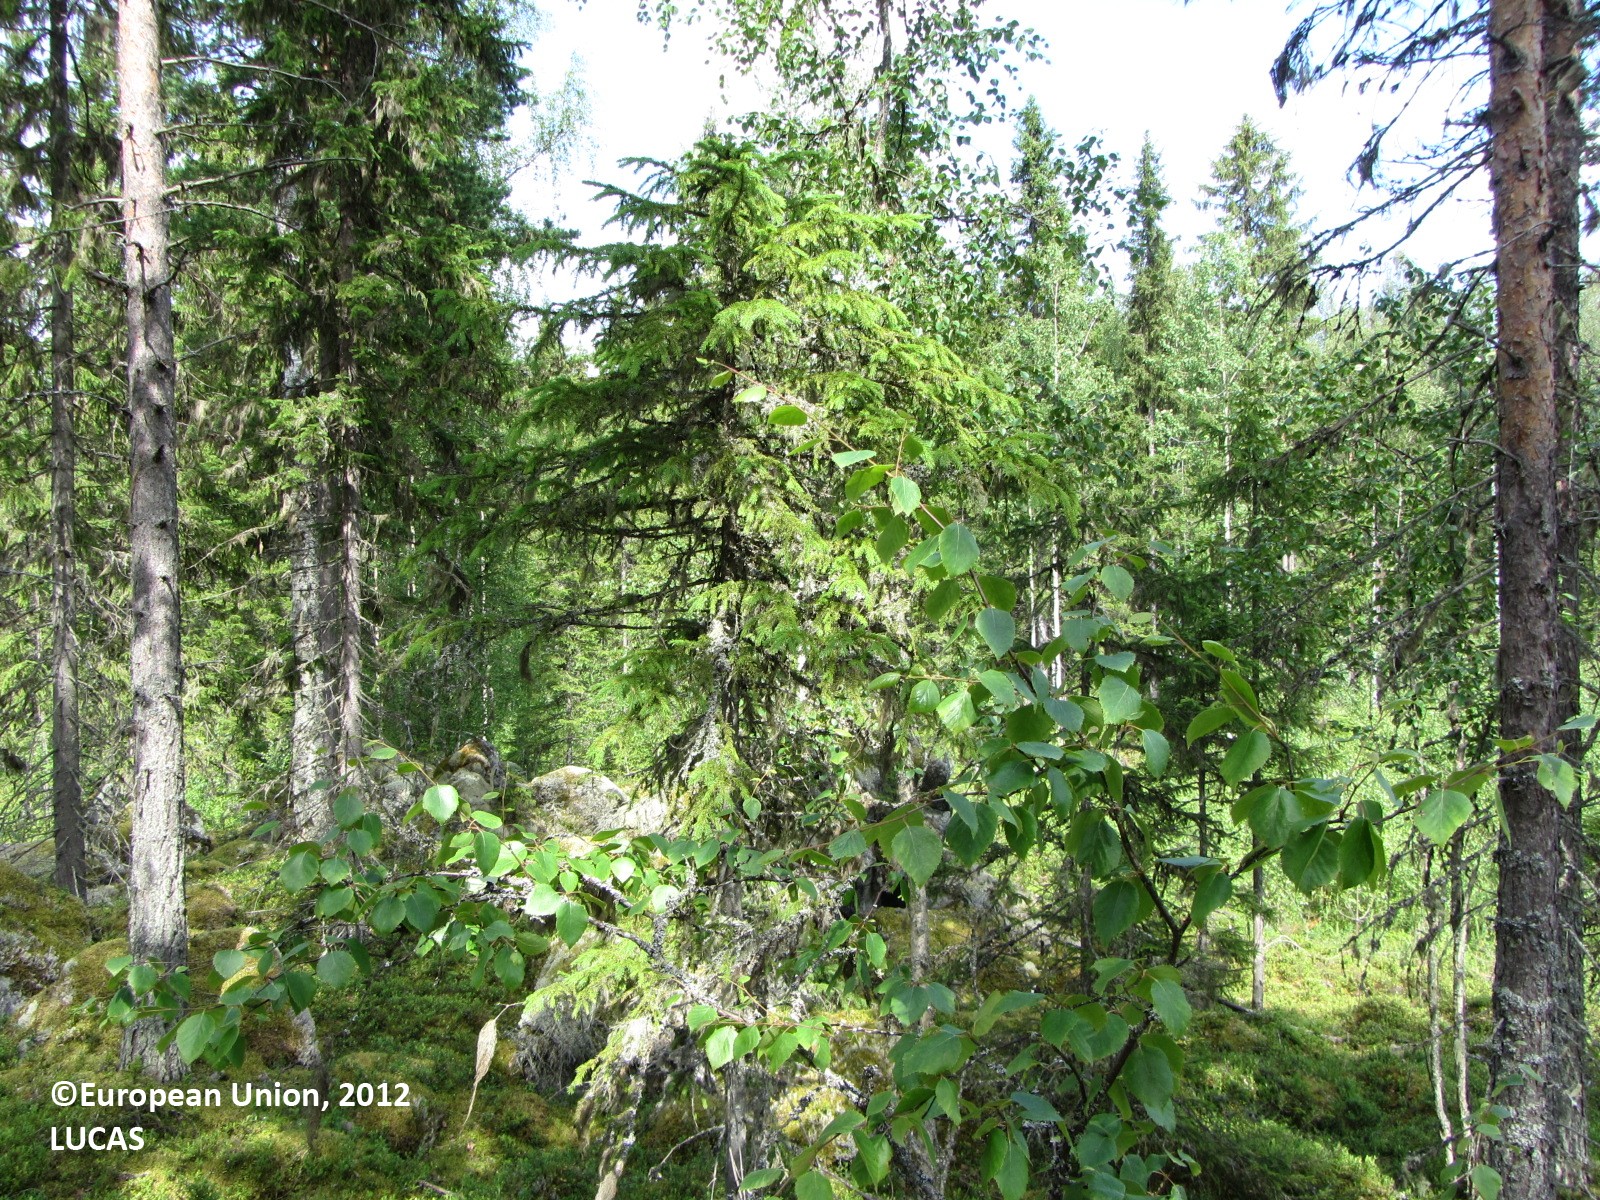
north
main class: Woodland
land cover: Pine dominated coniferous woodland
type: boreal forest
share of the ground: 50 - 75 %
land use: Forestry
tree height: > 5 m
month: July
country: FI
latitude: 63.6730
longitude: 25.4375
